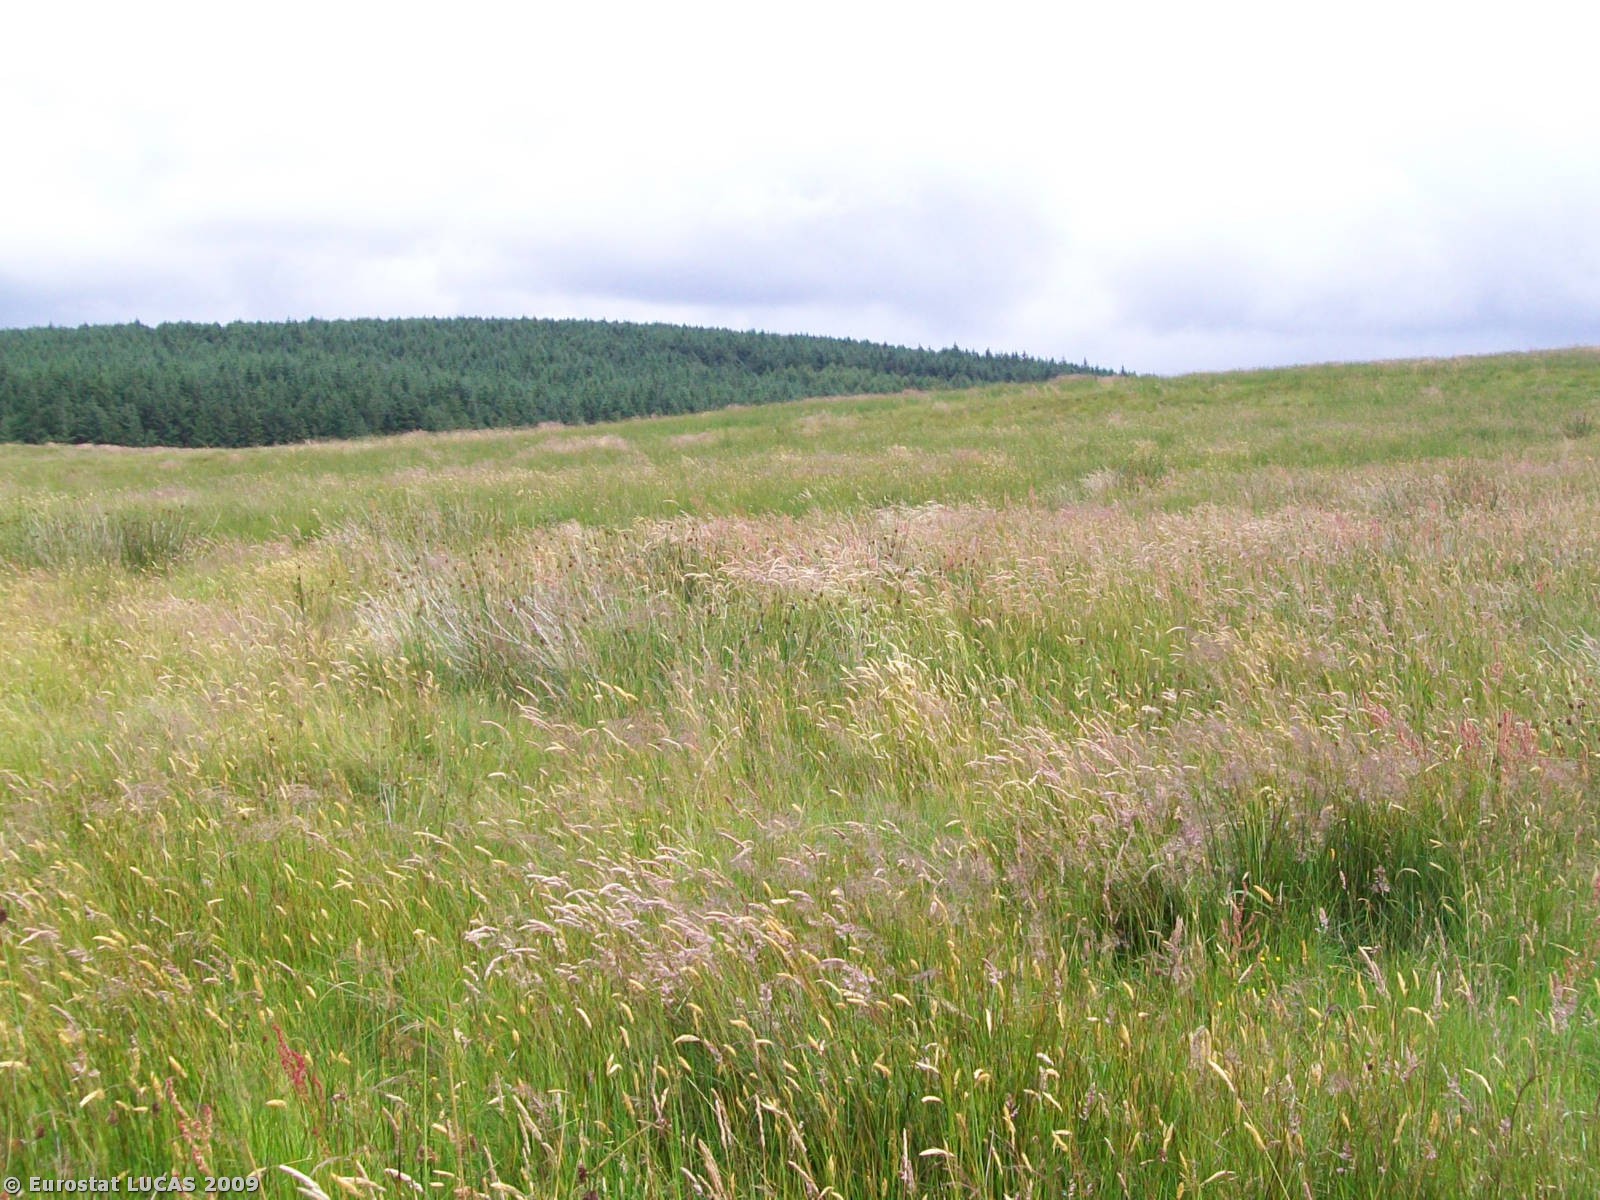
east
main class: Wetlands
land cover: Peatbogs
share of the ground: > 75 %
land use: Unused
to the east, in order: Peatbogs
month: July
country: GB
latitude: 55.0491
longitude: -6.2525
